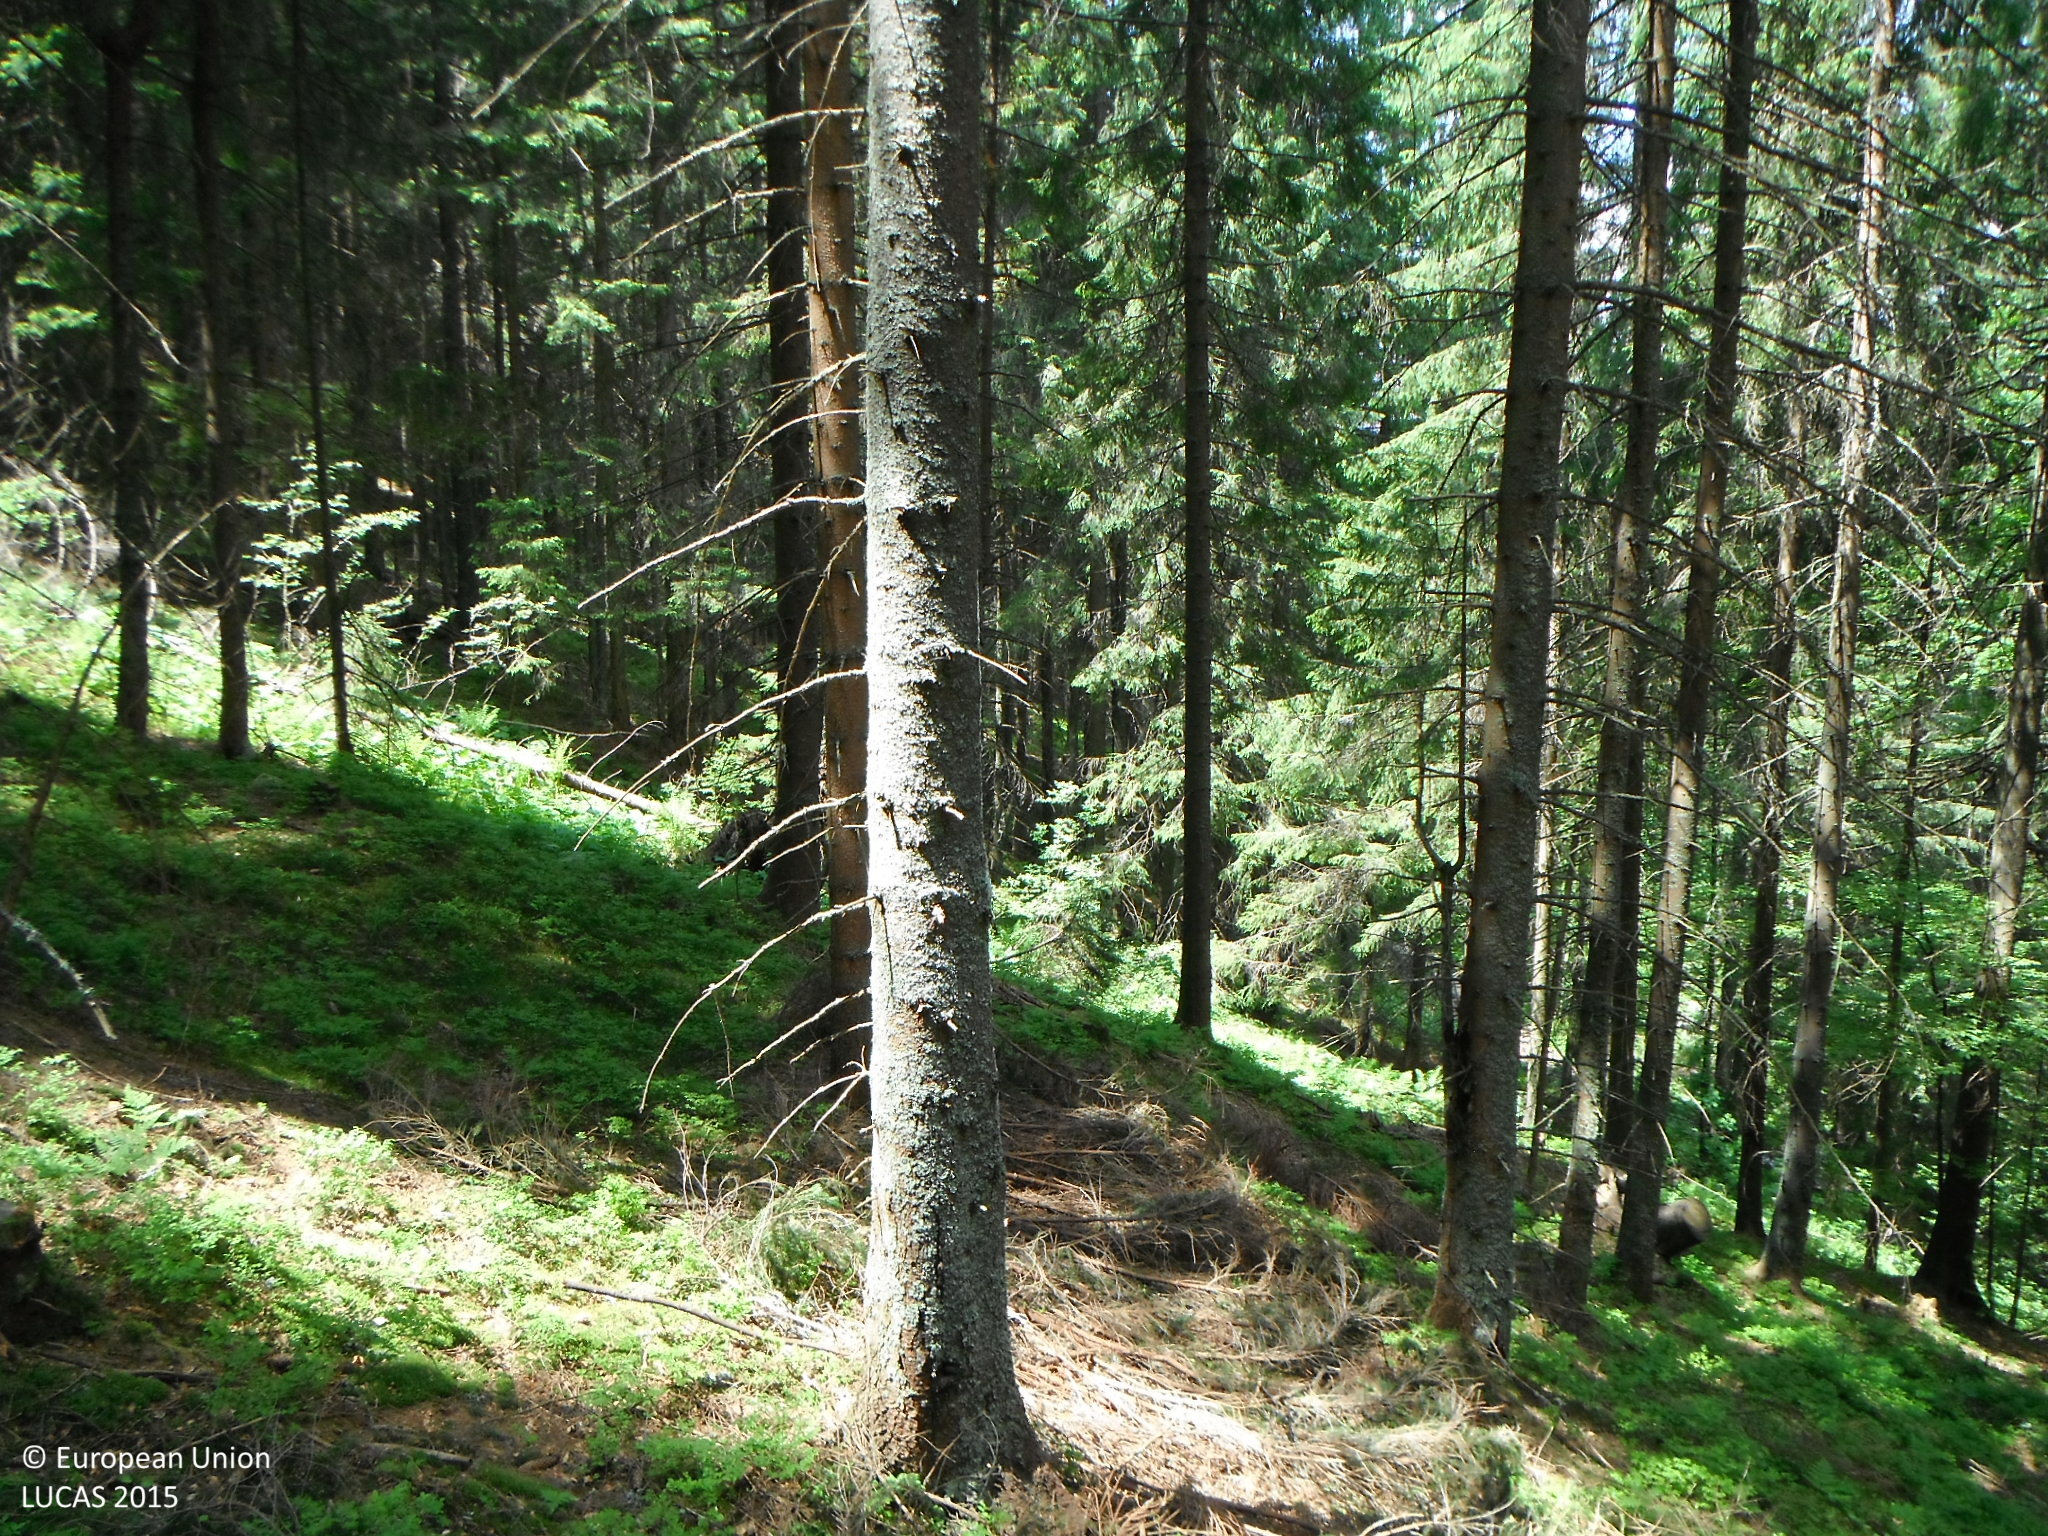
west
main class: Woodland
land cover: Spruce dominated coniferous woodland
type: alpine coniferous forest
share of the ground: > 75 %
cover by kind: coniferous forest trees 90 %, herbaceous plants 10 %
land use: Forestry
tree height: > 5 m
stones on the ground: < 10 %
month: June
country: SK
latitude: 48.9413
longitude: 19.4320
